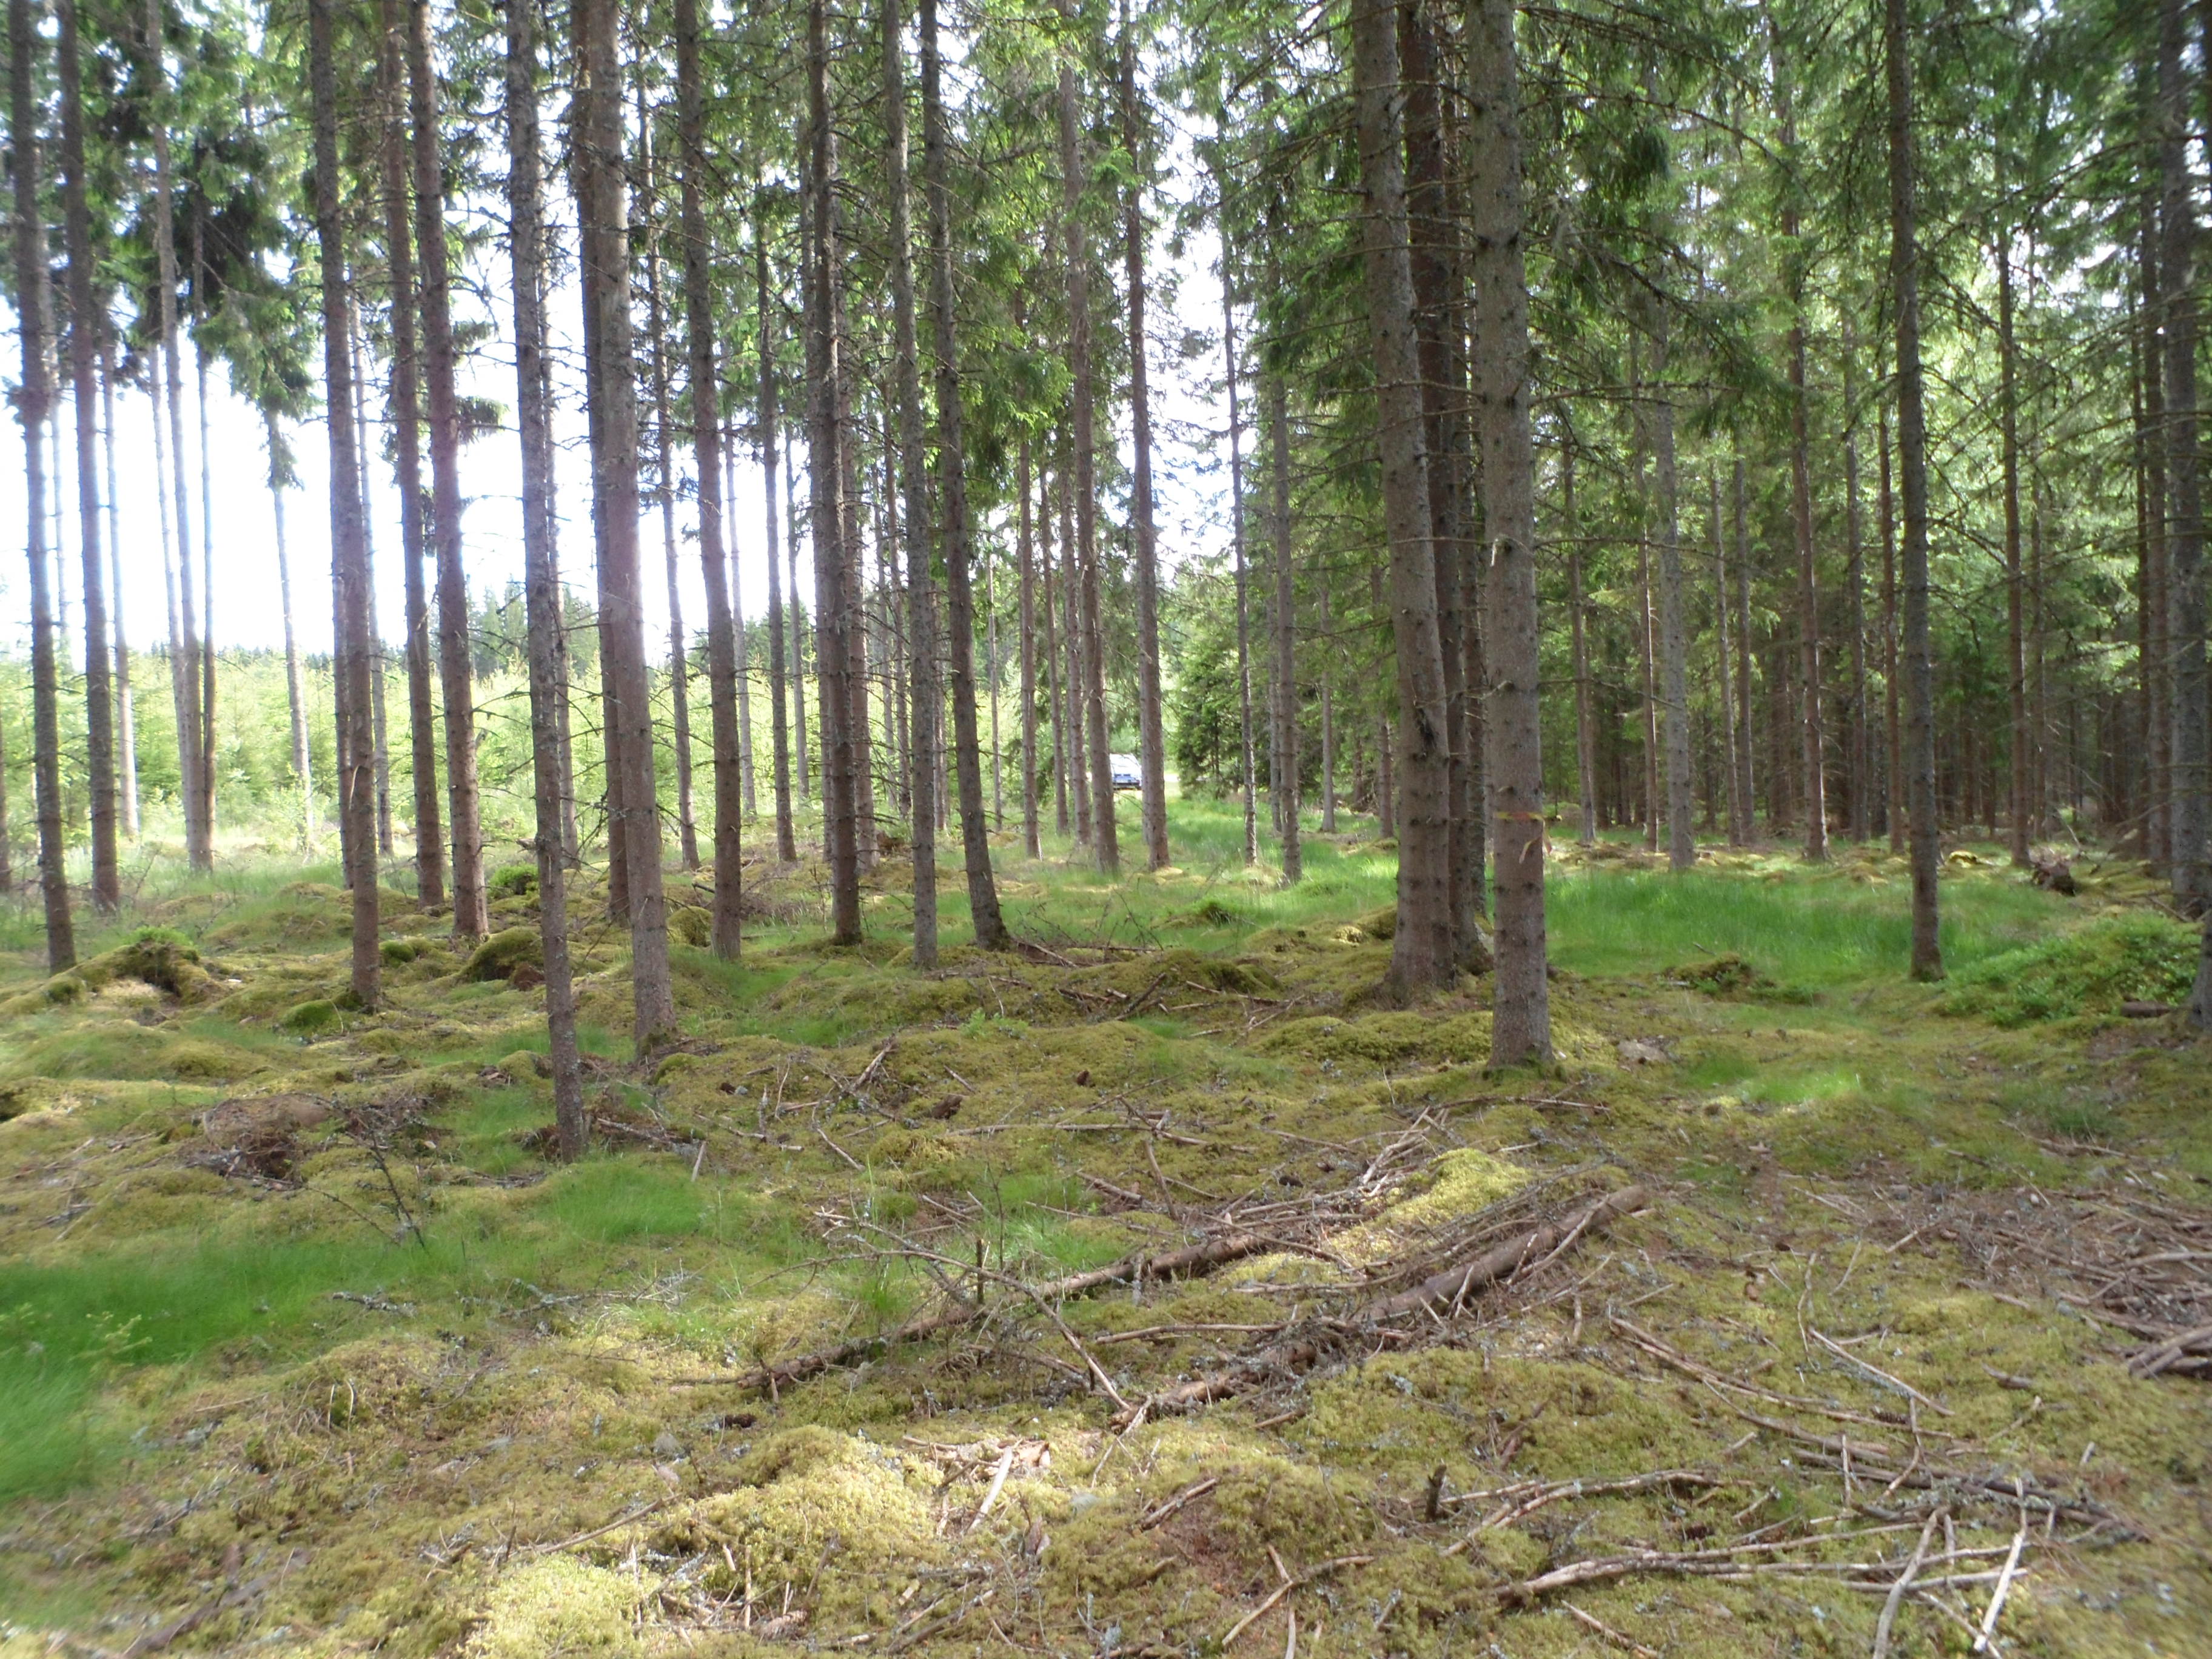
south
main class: Woodland
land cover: Spruce dominated coniferous woodland
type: boreal forest
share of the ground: 50 - 75 %
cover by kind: coniferous forest trees 60 %, herbaceous plants 15 %, lichens and mosses 15 %, shrubs 10 %
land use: Forestry
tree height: > 5 m
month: June
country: SE
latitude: 57.3740
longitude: 14.3695
